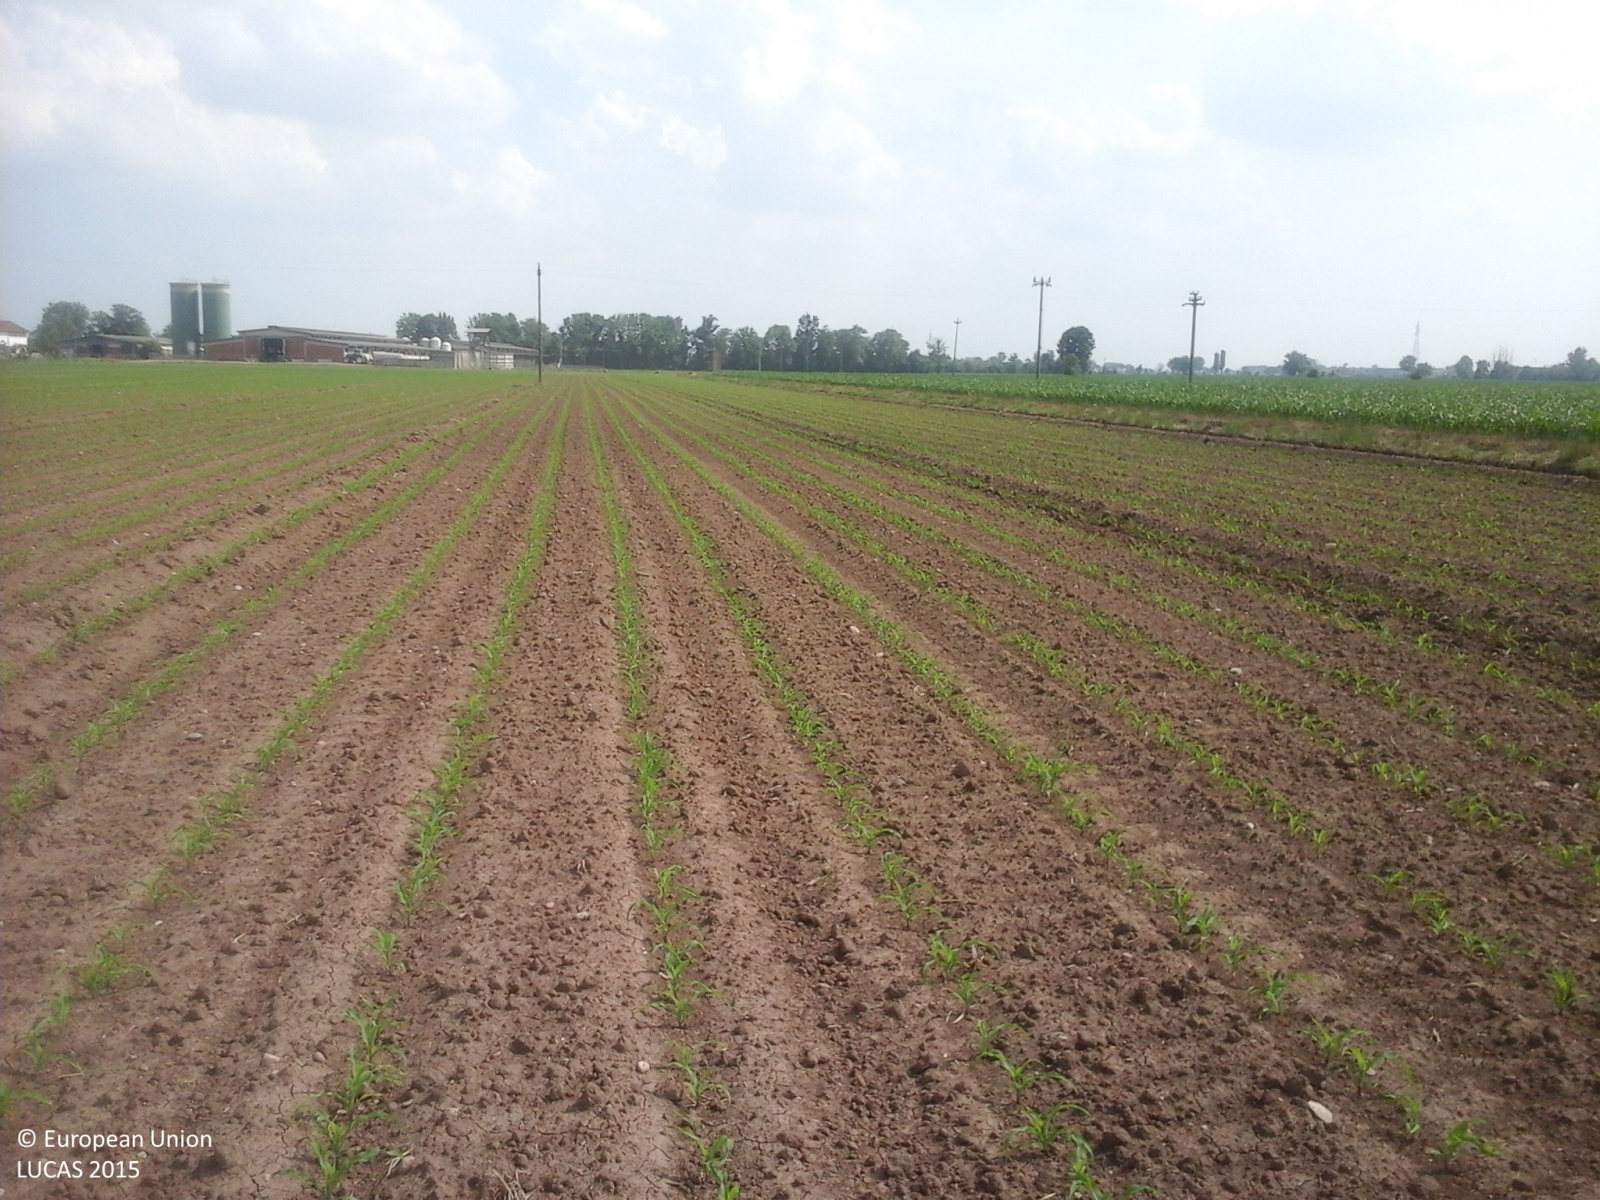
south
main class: Cropland
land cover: Maize
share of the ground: < 10 %
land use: Agriculture (excluding fallow land and kitchen gardens)
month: June
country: IT
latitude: 44.7410
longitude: 7.7438
